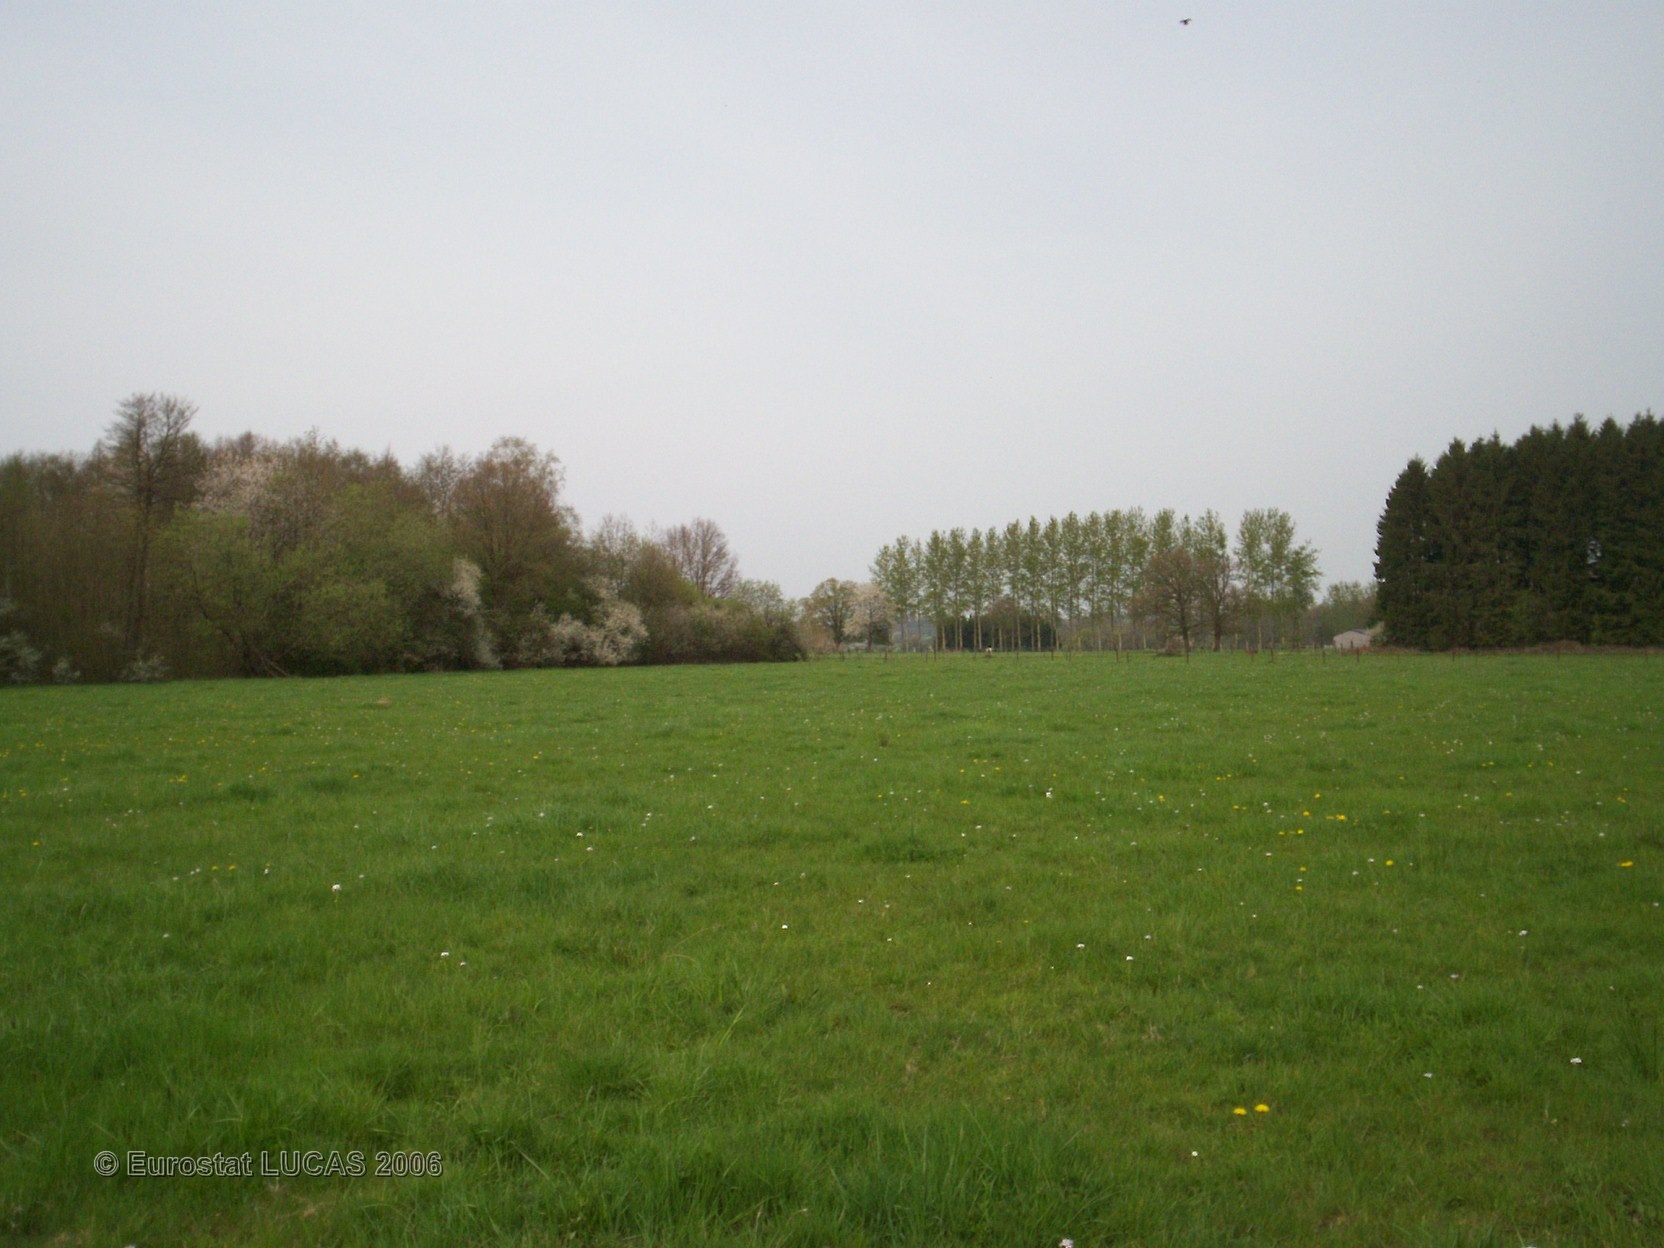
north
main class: Grassland
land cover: Grassland without tree/shrub cover
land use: Agriculture (excluding fallow land and kitchen gardens)
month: May
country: FR
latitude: 49.8659
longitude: 4.3891
